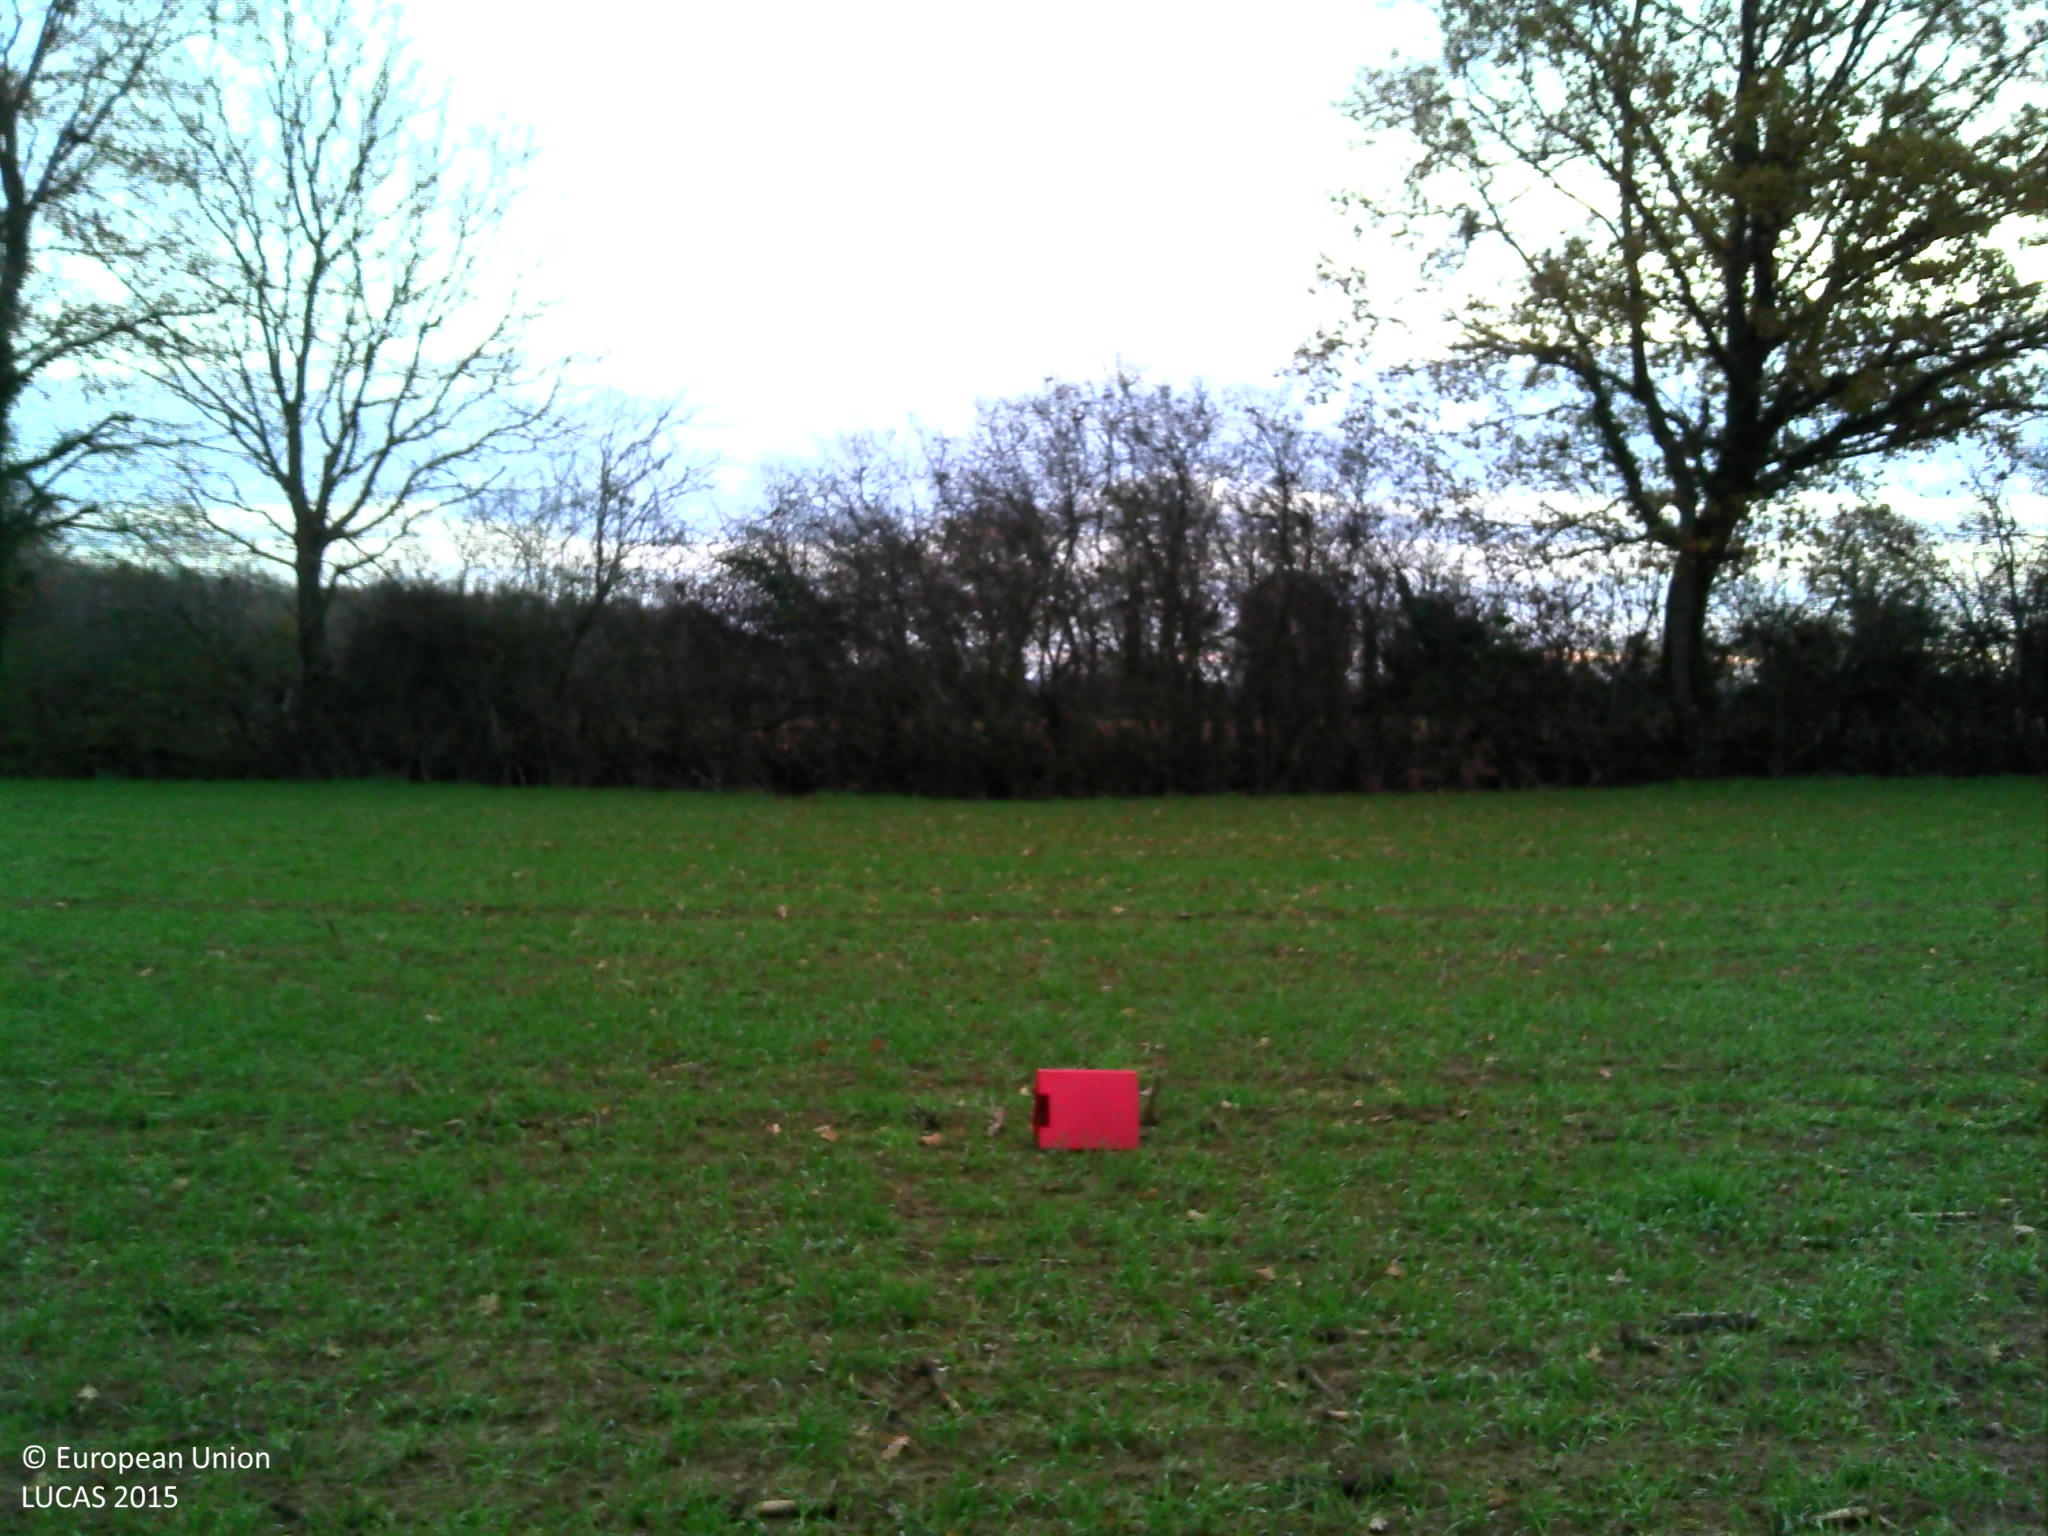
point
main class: Cropland
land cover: Common wheat
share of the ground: > 75 %
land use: Agriculture (excluding fallow land and kitchen gardens)
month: December
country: FR
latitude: 46.2024
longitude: 5.0911
